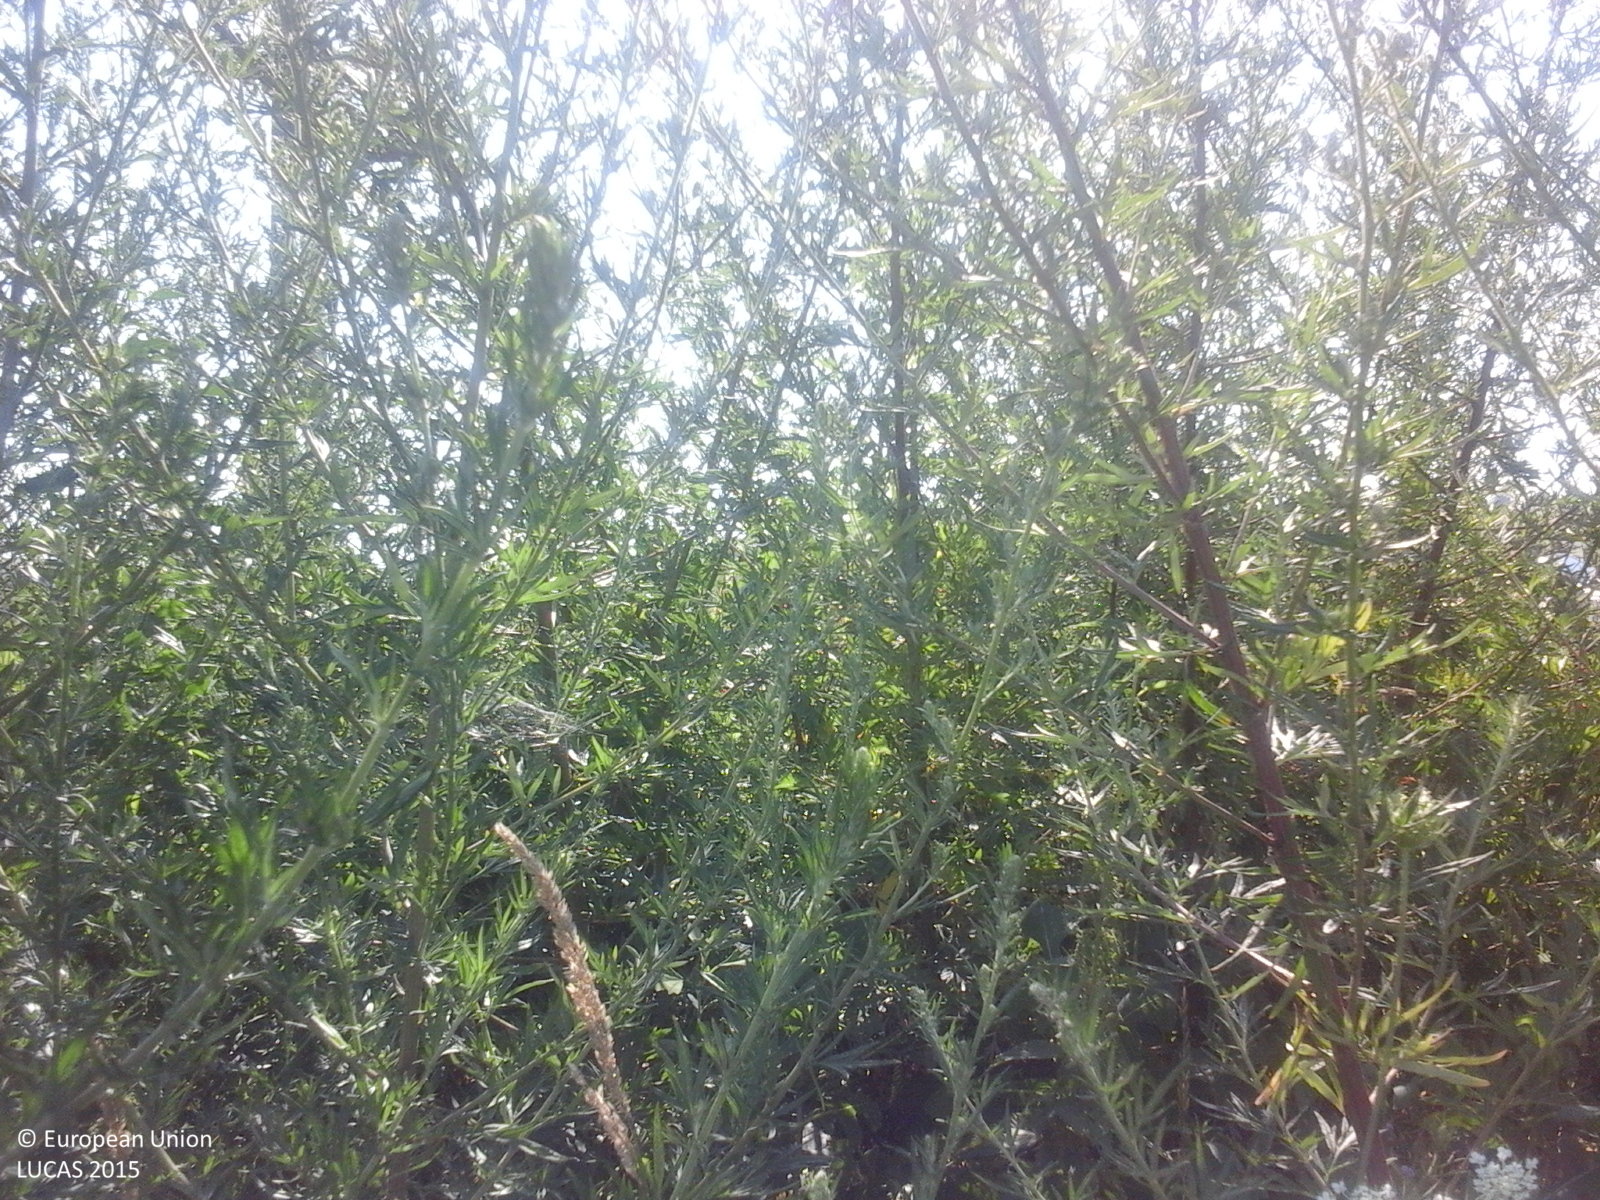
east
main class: Grassland
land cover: Spontaneously vegetated surfaces
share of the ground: > 75 %
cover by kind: herbaceous plants 100 %
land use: Semi-natural and natural areas not in use
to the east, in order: Spontaneously vegetated surfaces; Fences; Abandoned hedges; Grassland without tree/shrub cover; Fences; Spontaneously vegetated surfaces; Artificial constructions in urban areas; Arable land (only in case pi); Artificial constructions in urban areas; Other fruit trees and berries; Managed hedges; Grass margins; Tracks; Grass margins
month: July
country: RO
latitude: 44.3247
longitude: 24.5536
